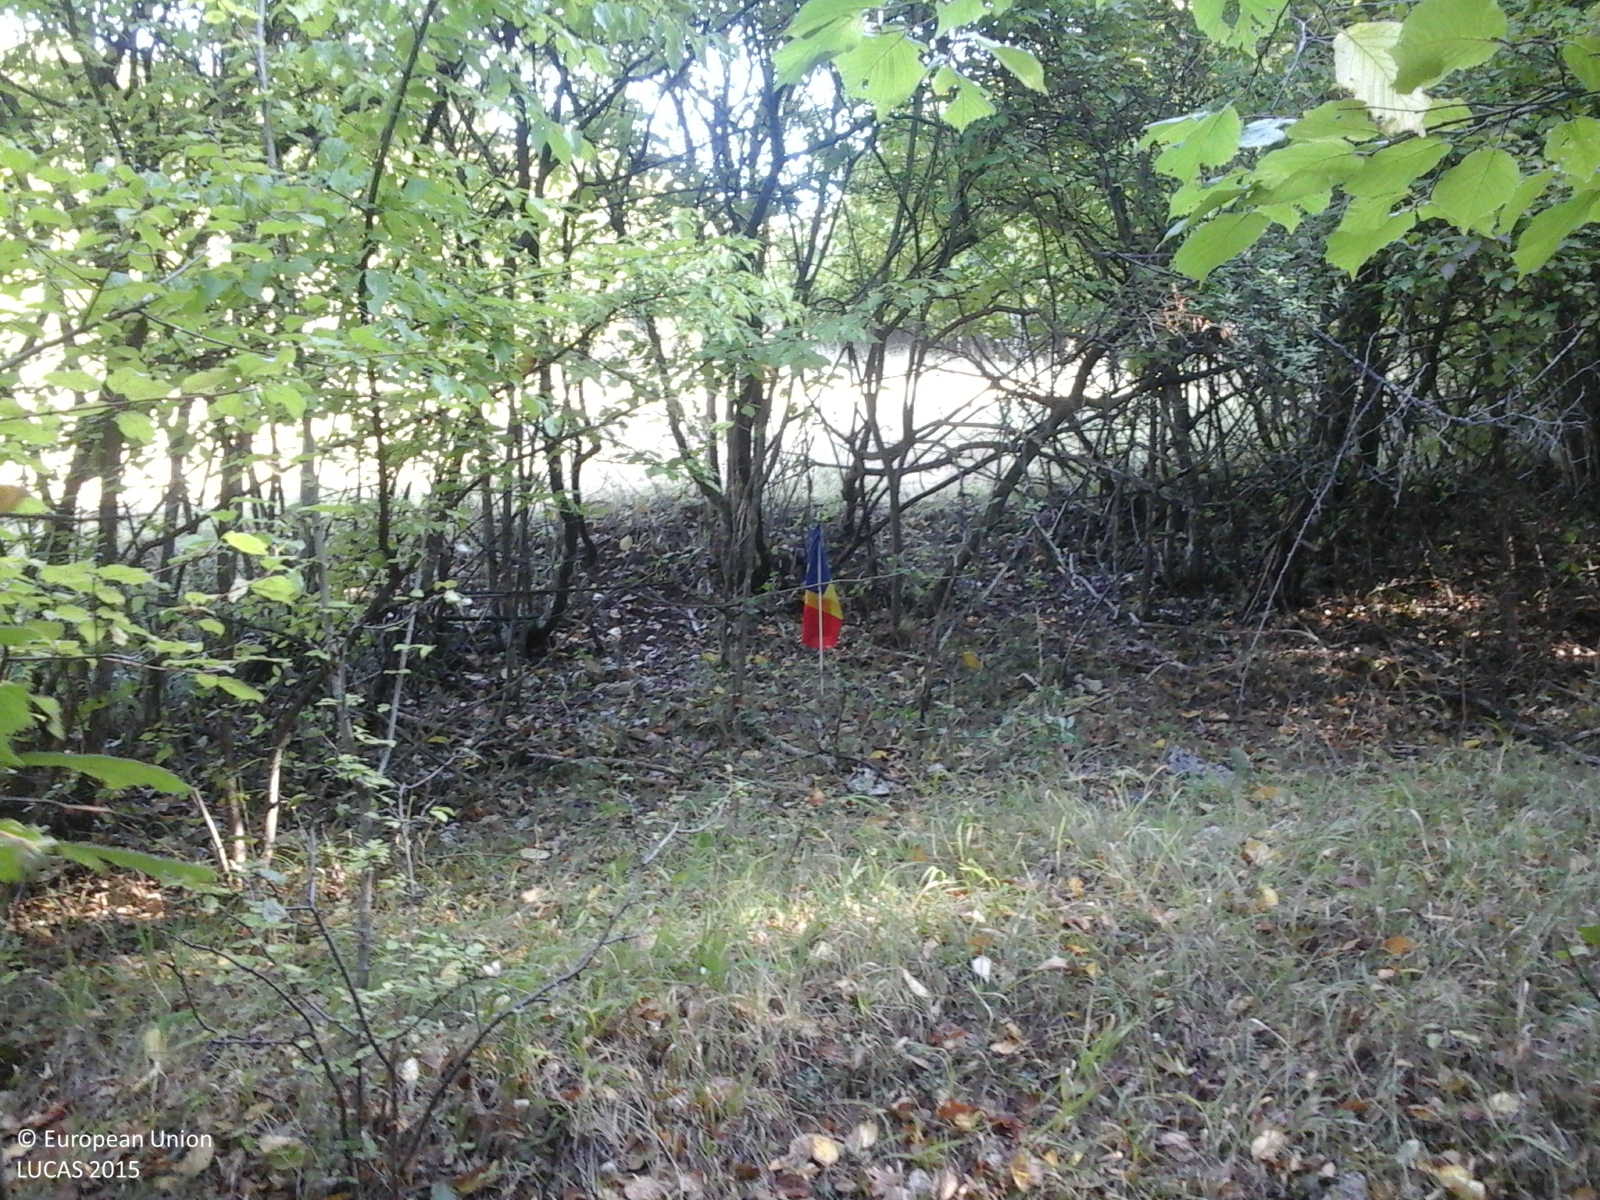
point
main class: Woodland
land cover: Broadleaved woodland
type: beech forest
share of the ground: > 75 %
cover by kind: broadleaved forest trees 100 %
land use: Forestry
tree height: > 5 m
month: September
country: RO
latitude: 47.3638
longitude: 23.4051
